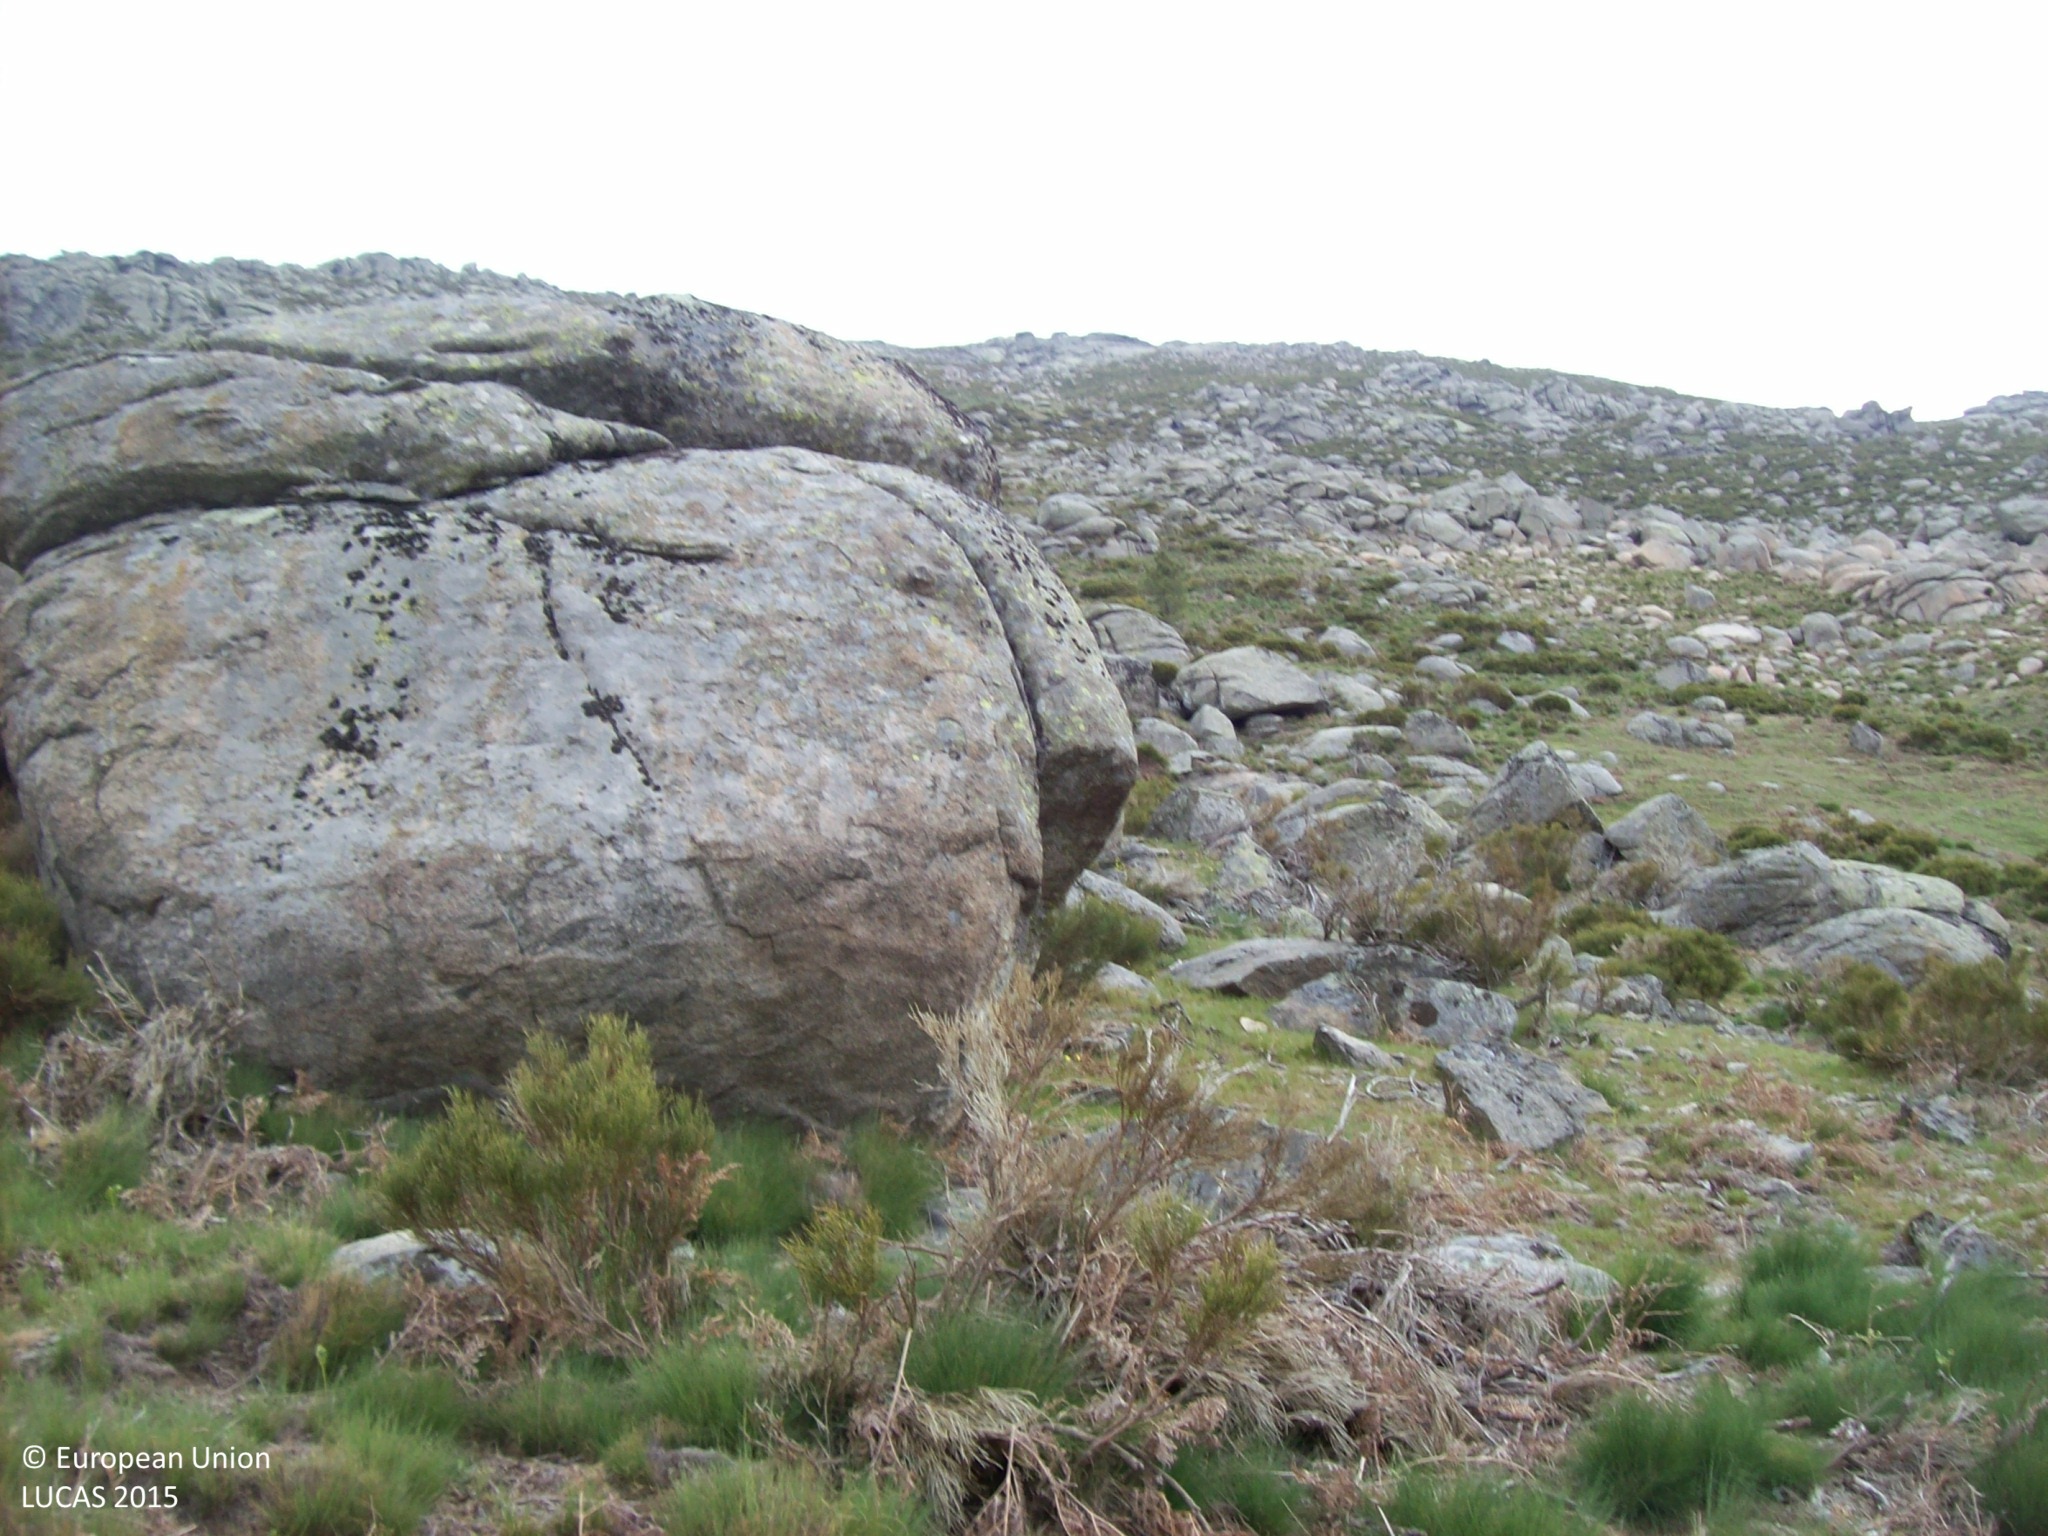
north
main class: Shrubland
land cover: Shrubland without tree cover
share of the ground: 25 - 50 %
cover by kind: shrubs 30 %, herbaceous plants 30 %, consolidated bare surface 30 %, unconsolidated bare surface 10 %
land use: Agriculture (excluding fallow land and kitchen gardens)
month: April
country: ES
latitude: 40.3274
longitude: -4.8239
